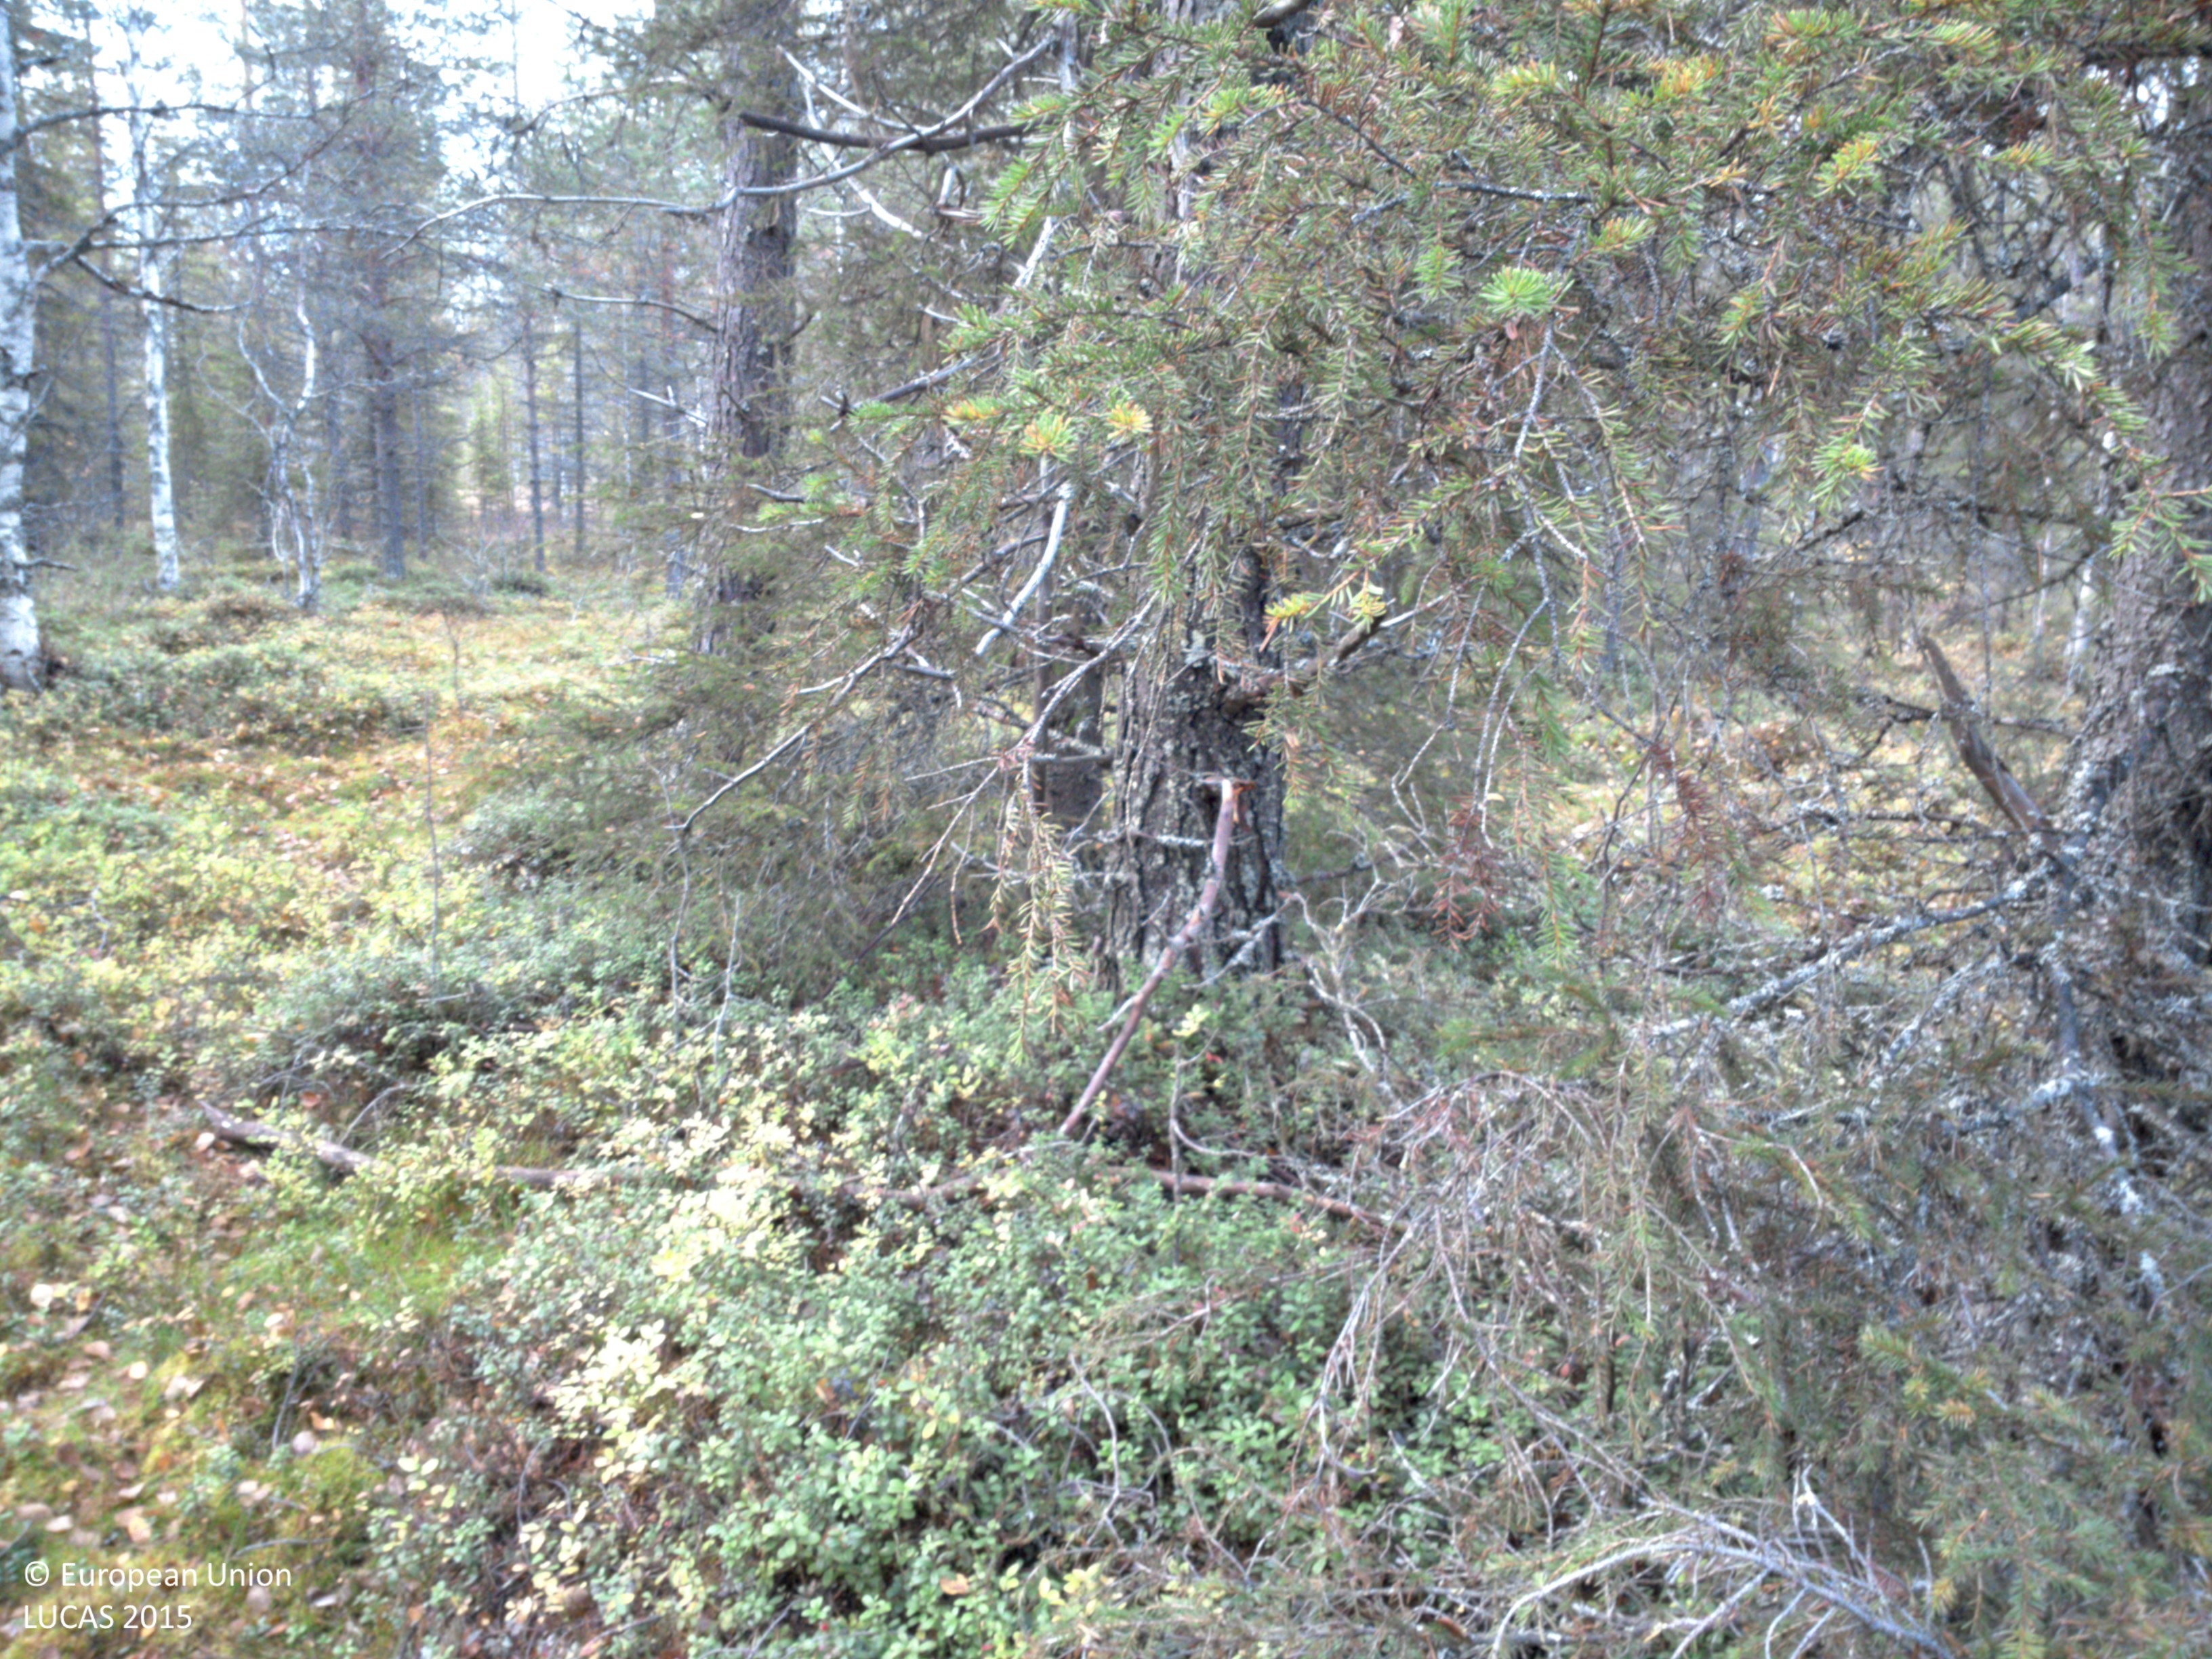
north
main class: Woodland
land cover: Pine dominated mixed woodland
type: boreal forest
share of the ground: > 75 %
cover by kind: coniferous forest trees 60 %, broadleaved forest trees 20 %, shrubs 15 %, lichens and mosses 5 %
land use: Forestry
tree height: > 5 m
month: September
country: SE
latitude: 65.0373
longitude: 18.6073
